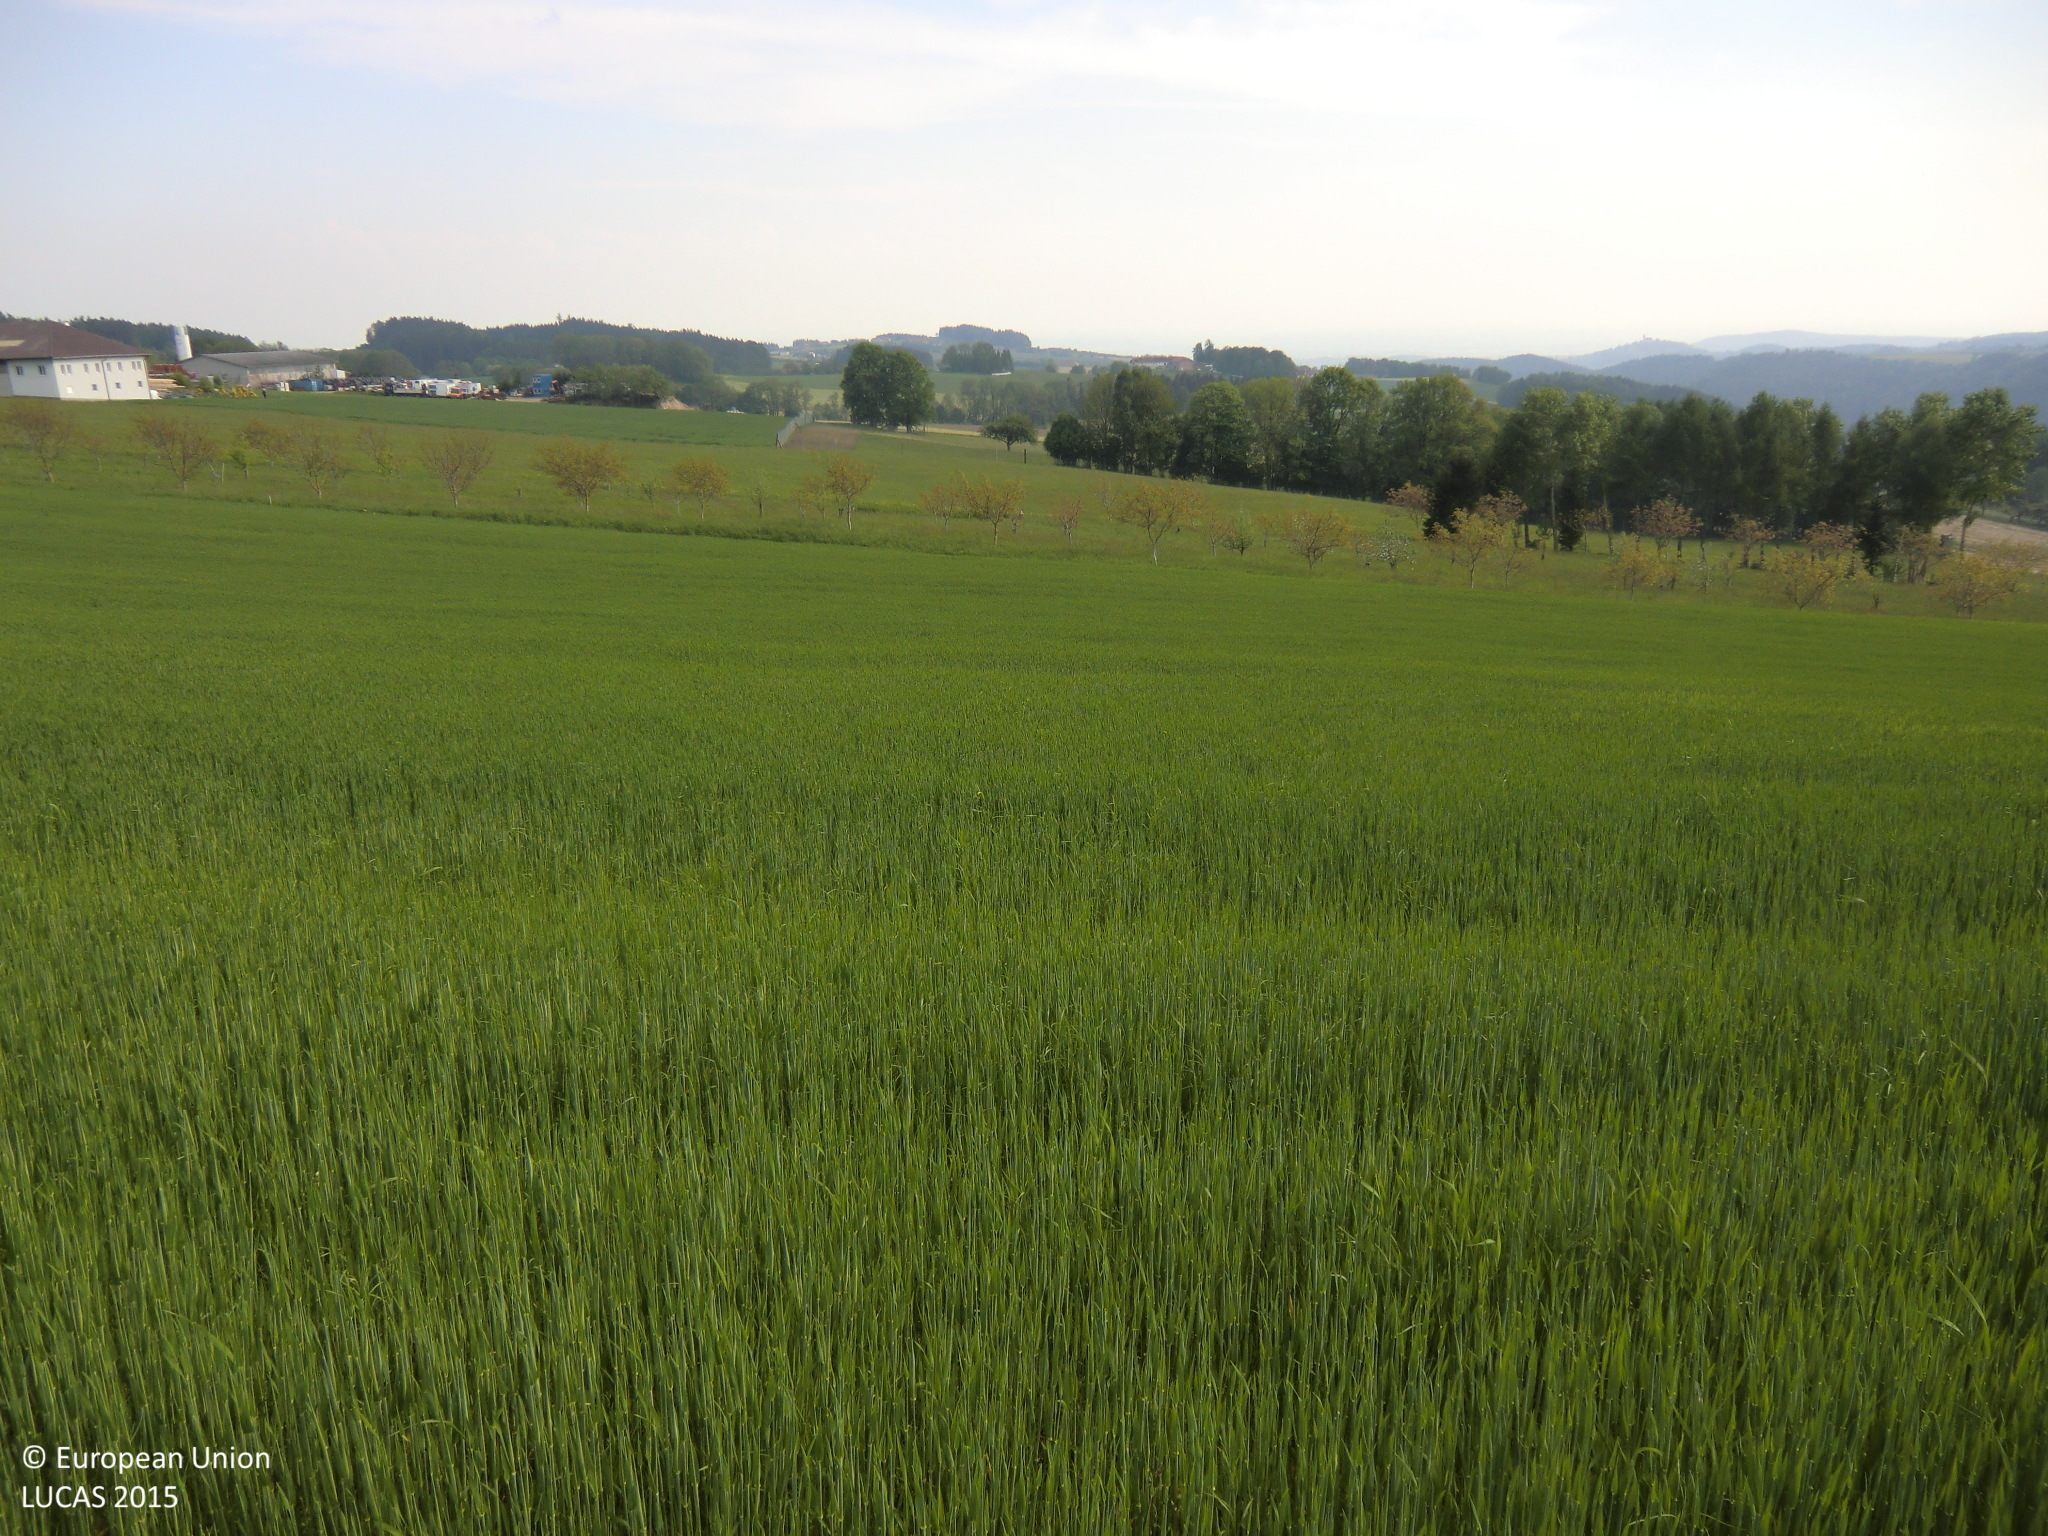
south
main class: Cropland
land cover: Barley
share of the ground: > 75 %
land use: Agriculture (excluding fallow land and kitchen gardens)
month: May
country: AT
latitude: 48.3916
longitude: 14.3084
